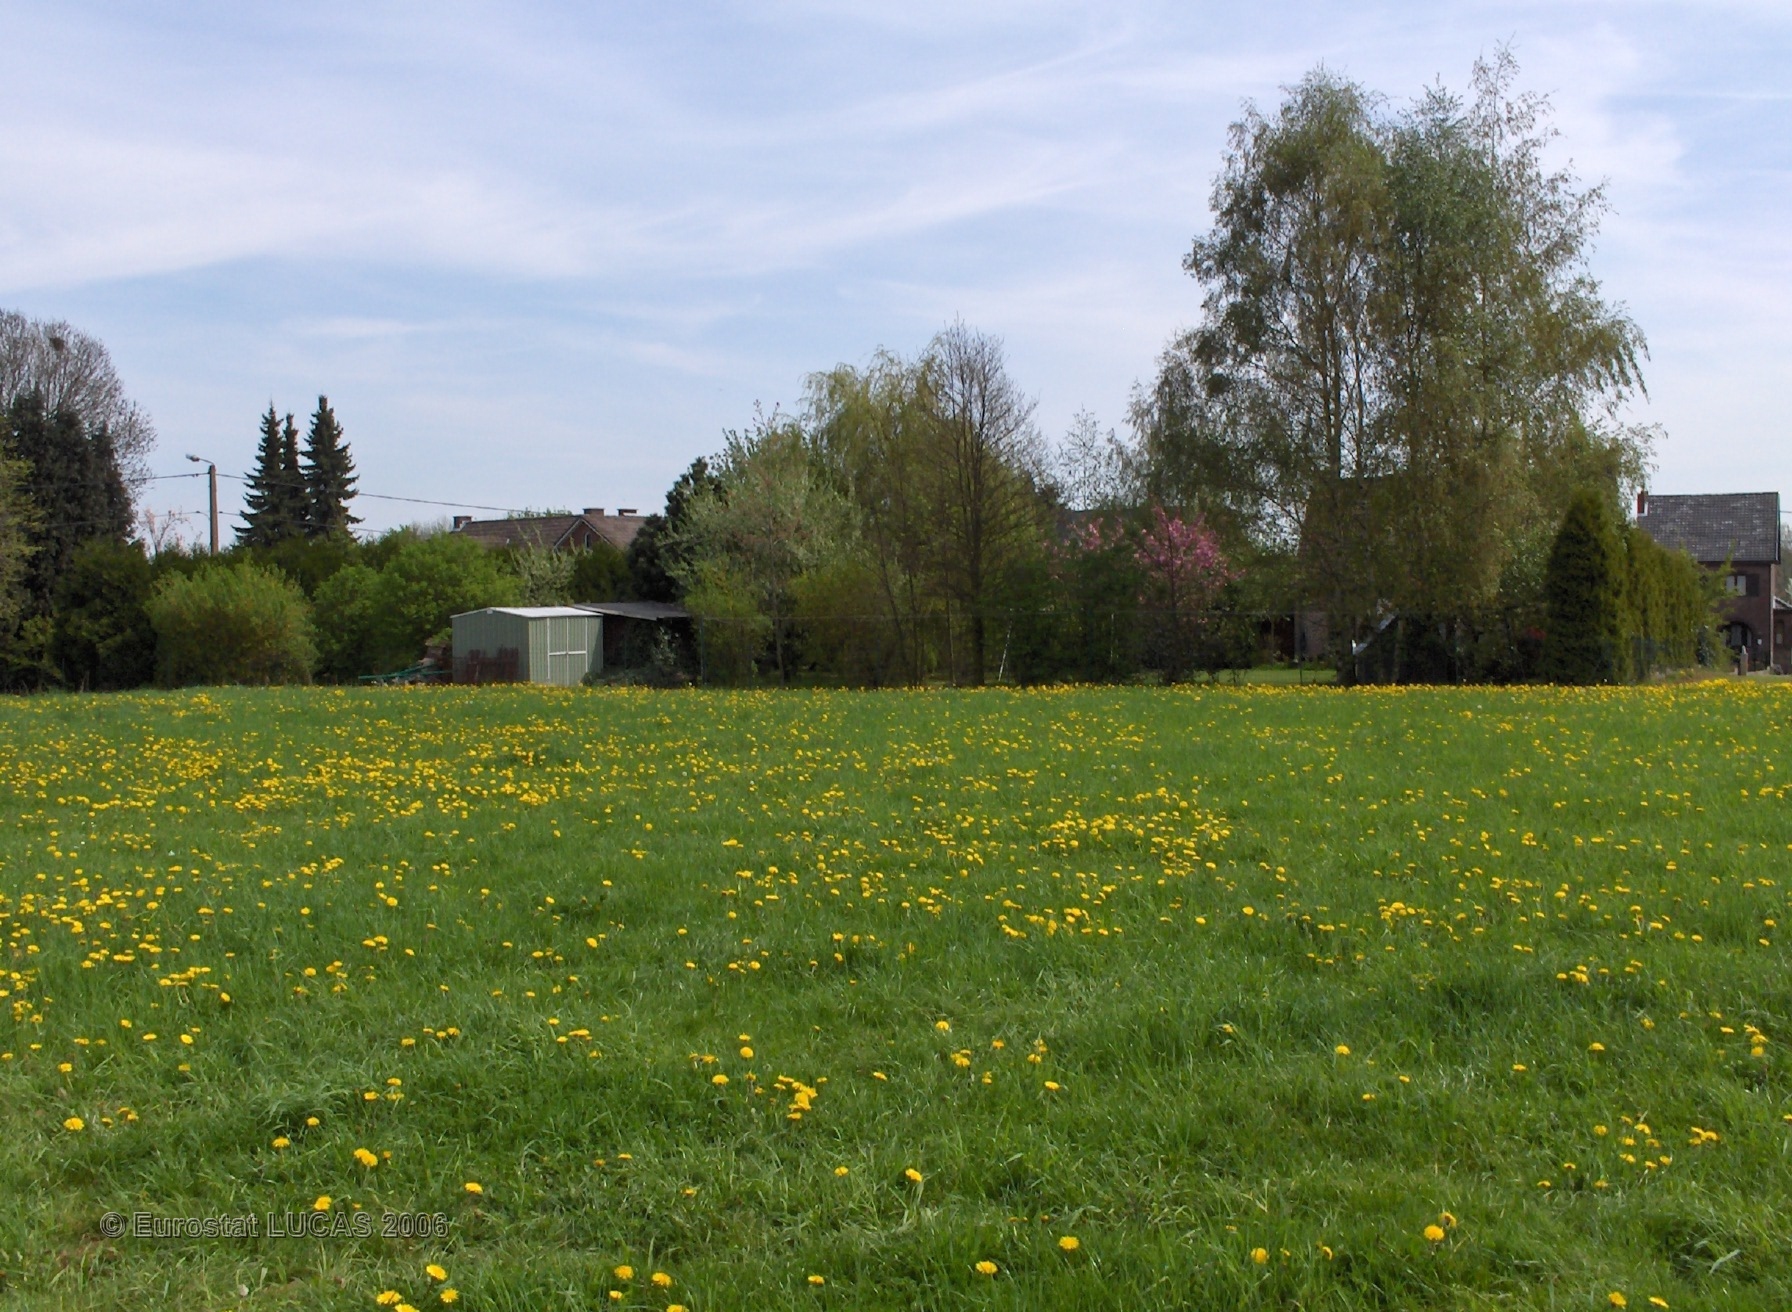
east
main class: Cropland
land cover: Other fibre and oleaginous crops
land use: Agriculture (excluding fallow land and kitchen gardens)
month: May
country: BE
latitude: 50.7338
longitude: 5.2512
